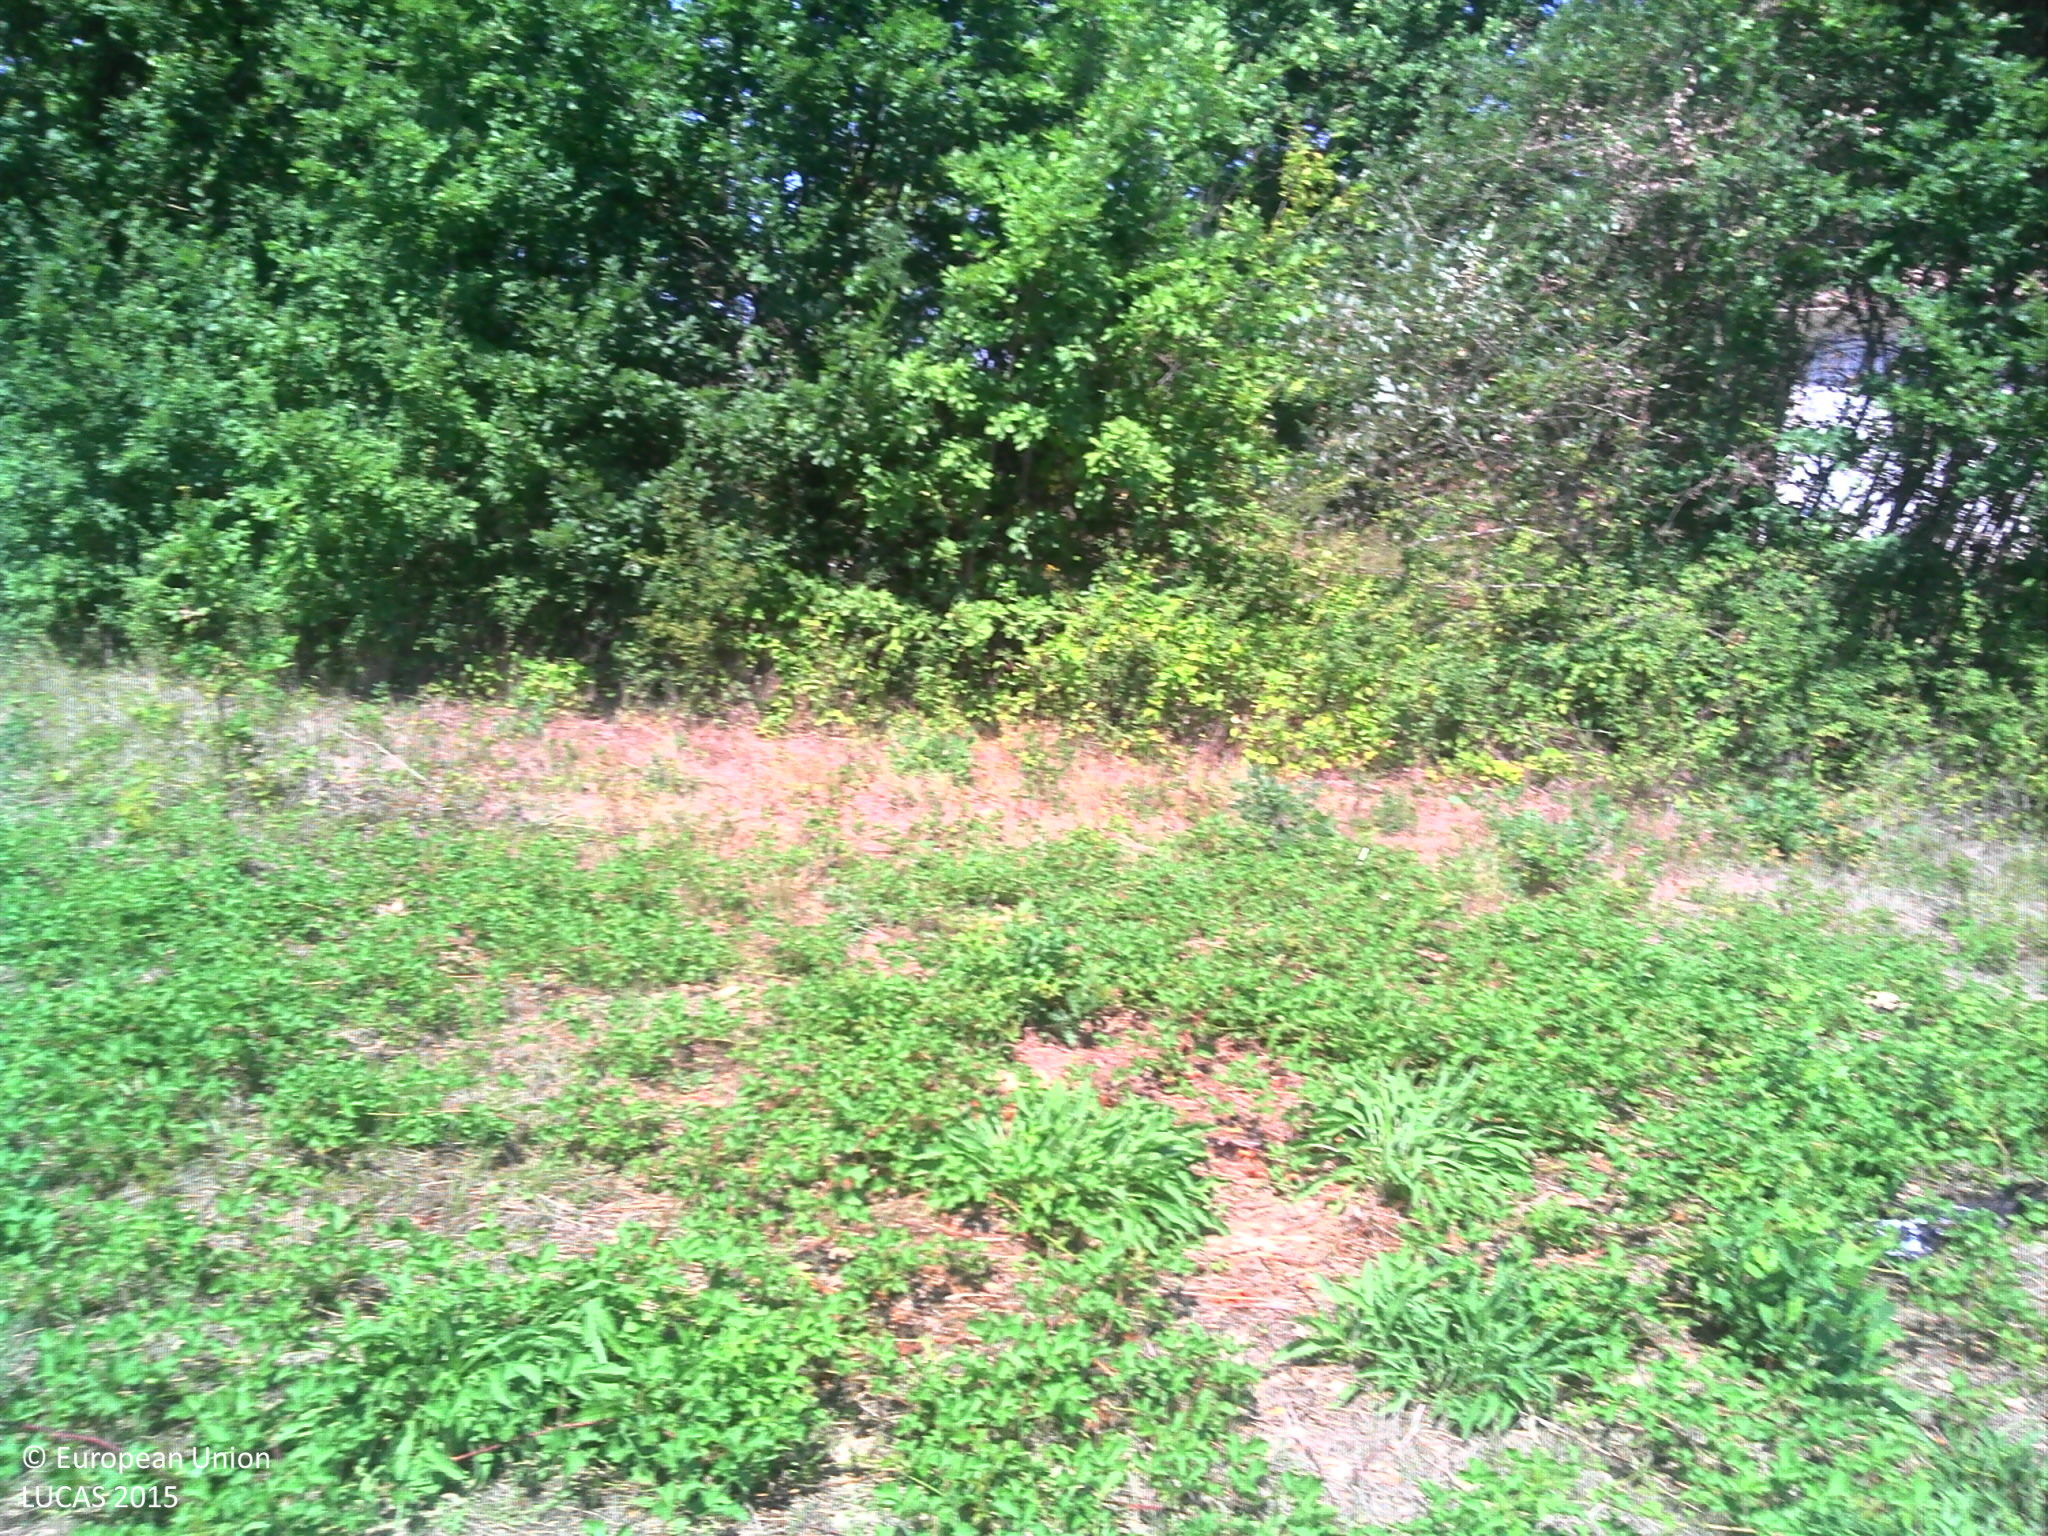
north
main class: Grassland
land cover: Grassland without tree/shrub cover
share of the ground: > 75 %
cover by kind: herbaceous plants 95 %, shrubs 5 %
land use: Agriculture (excluding fallow land and kitchen gardens)
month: August
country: FR
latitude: 44.0591
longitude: 1.3237
